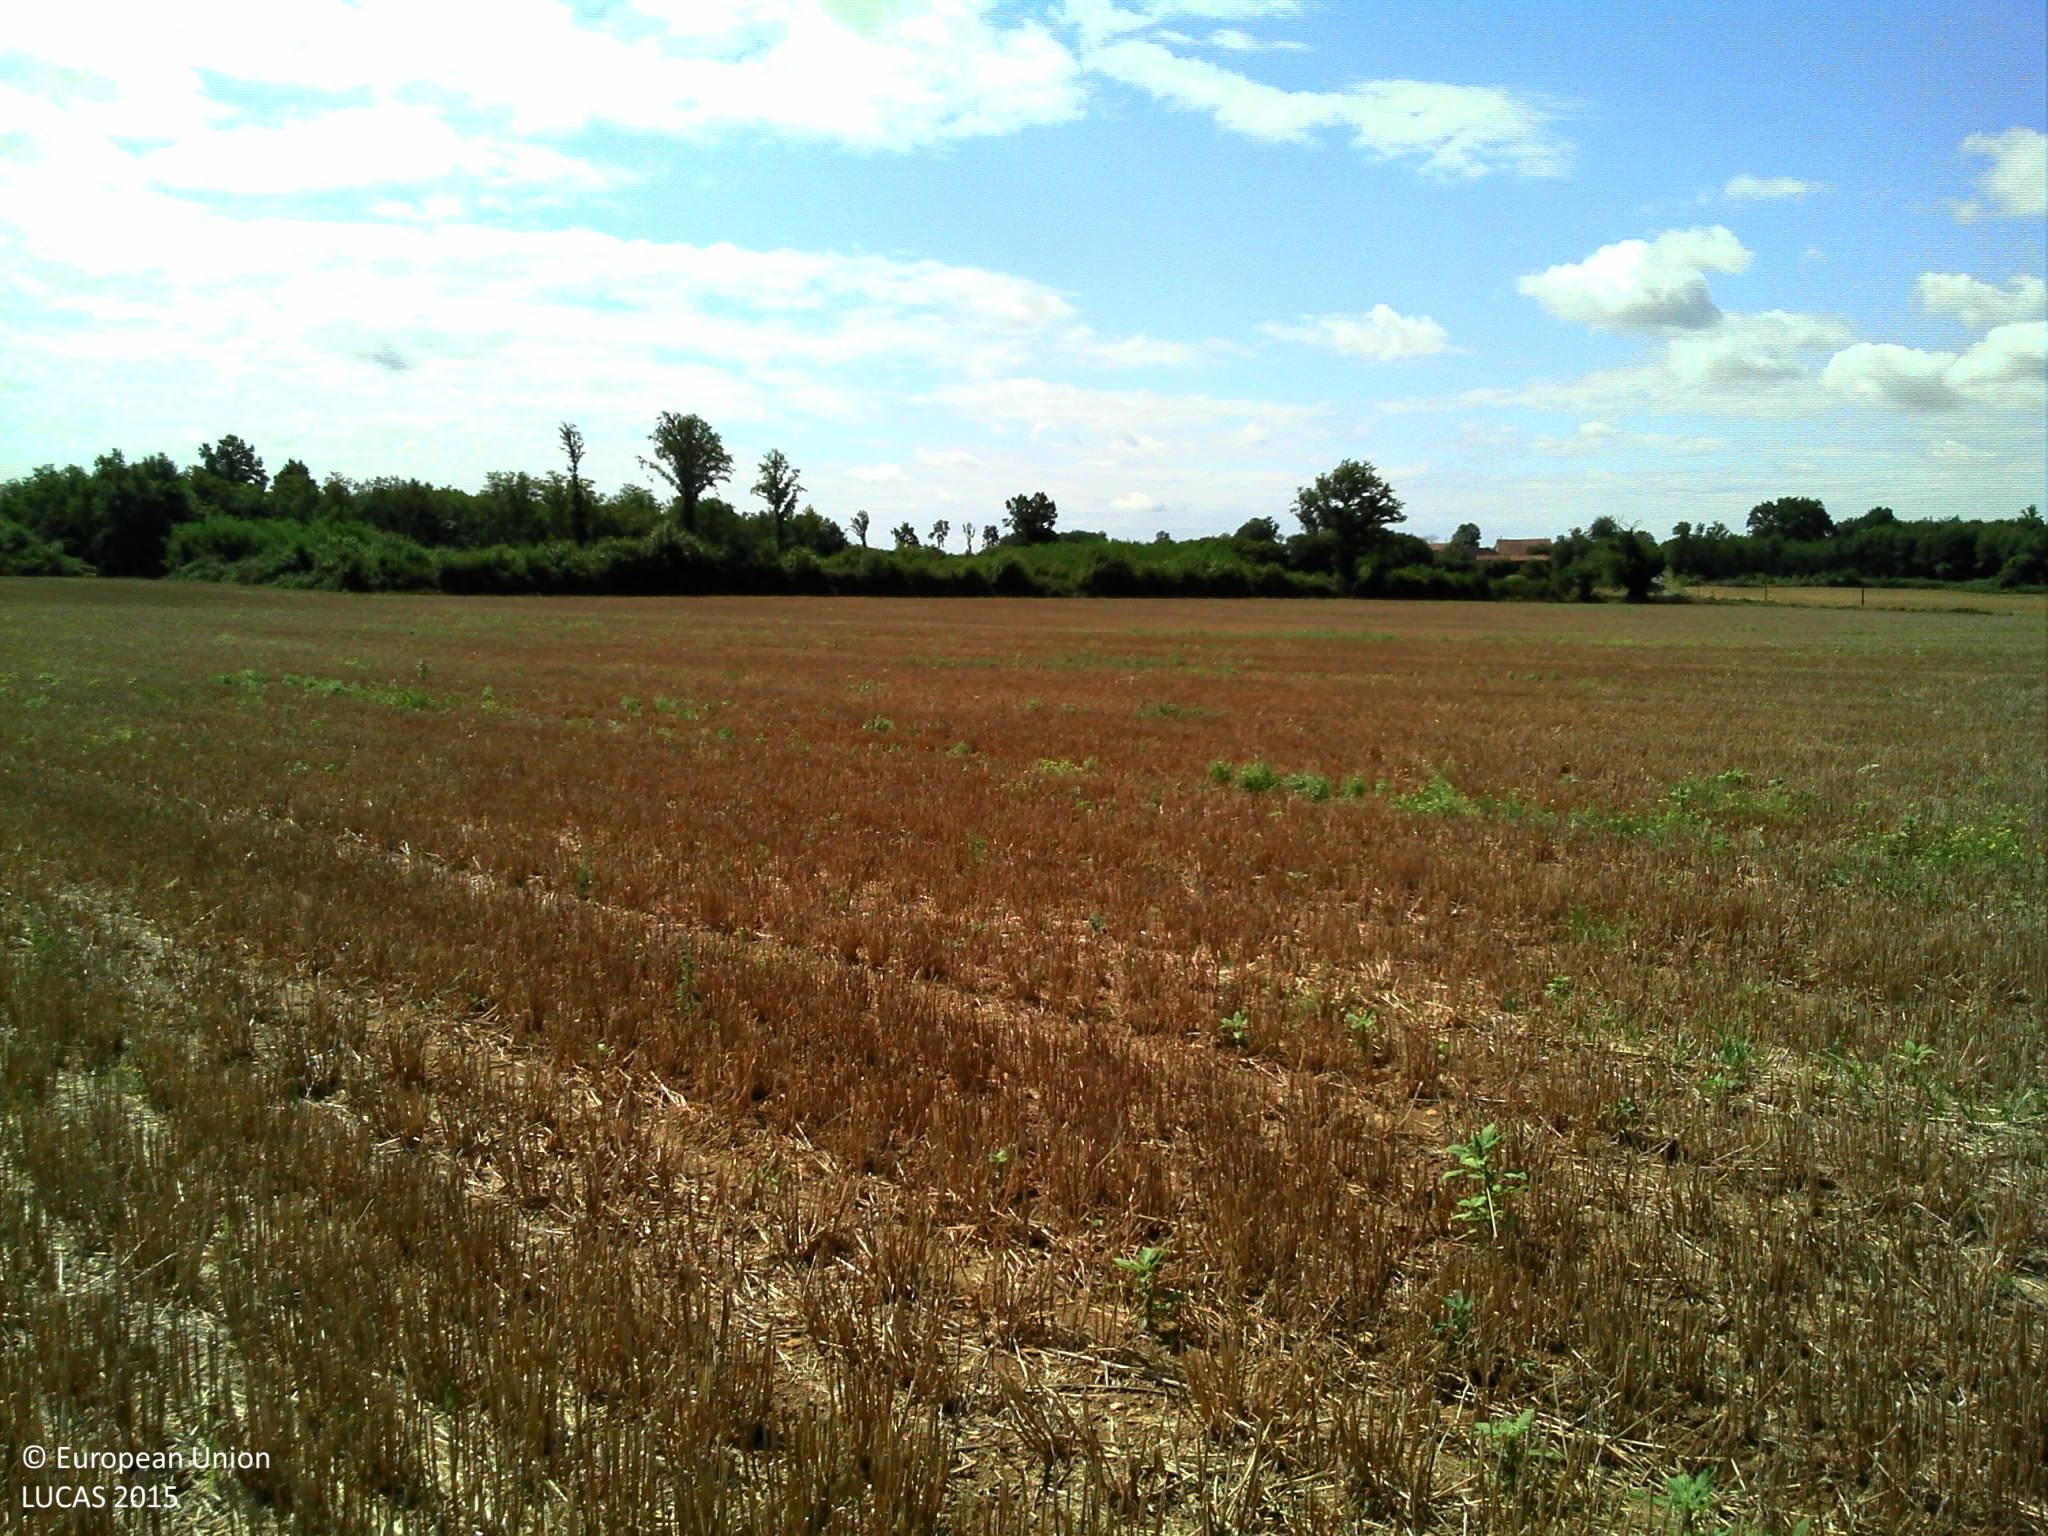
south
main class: Cropland
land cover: Barley
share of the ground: 50 - 75 %
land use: Agriculture (excluding fallow land and kitchen gardens)
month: August
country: FR
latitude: 46.0950
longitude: 0.3468
